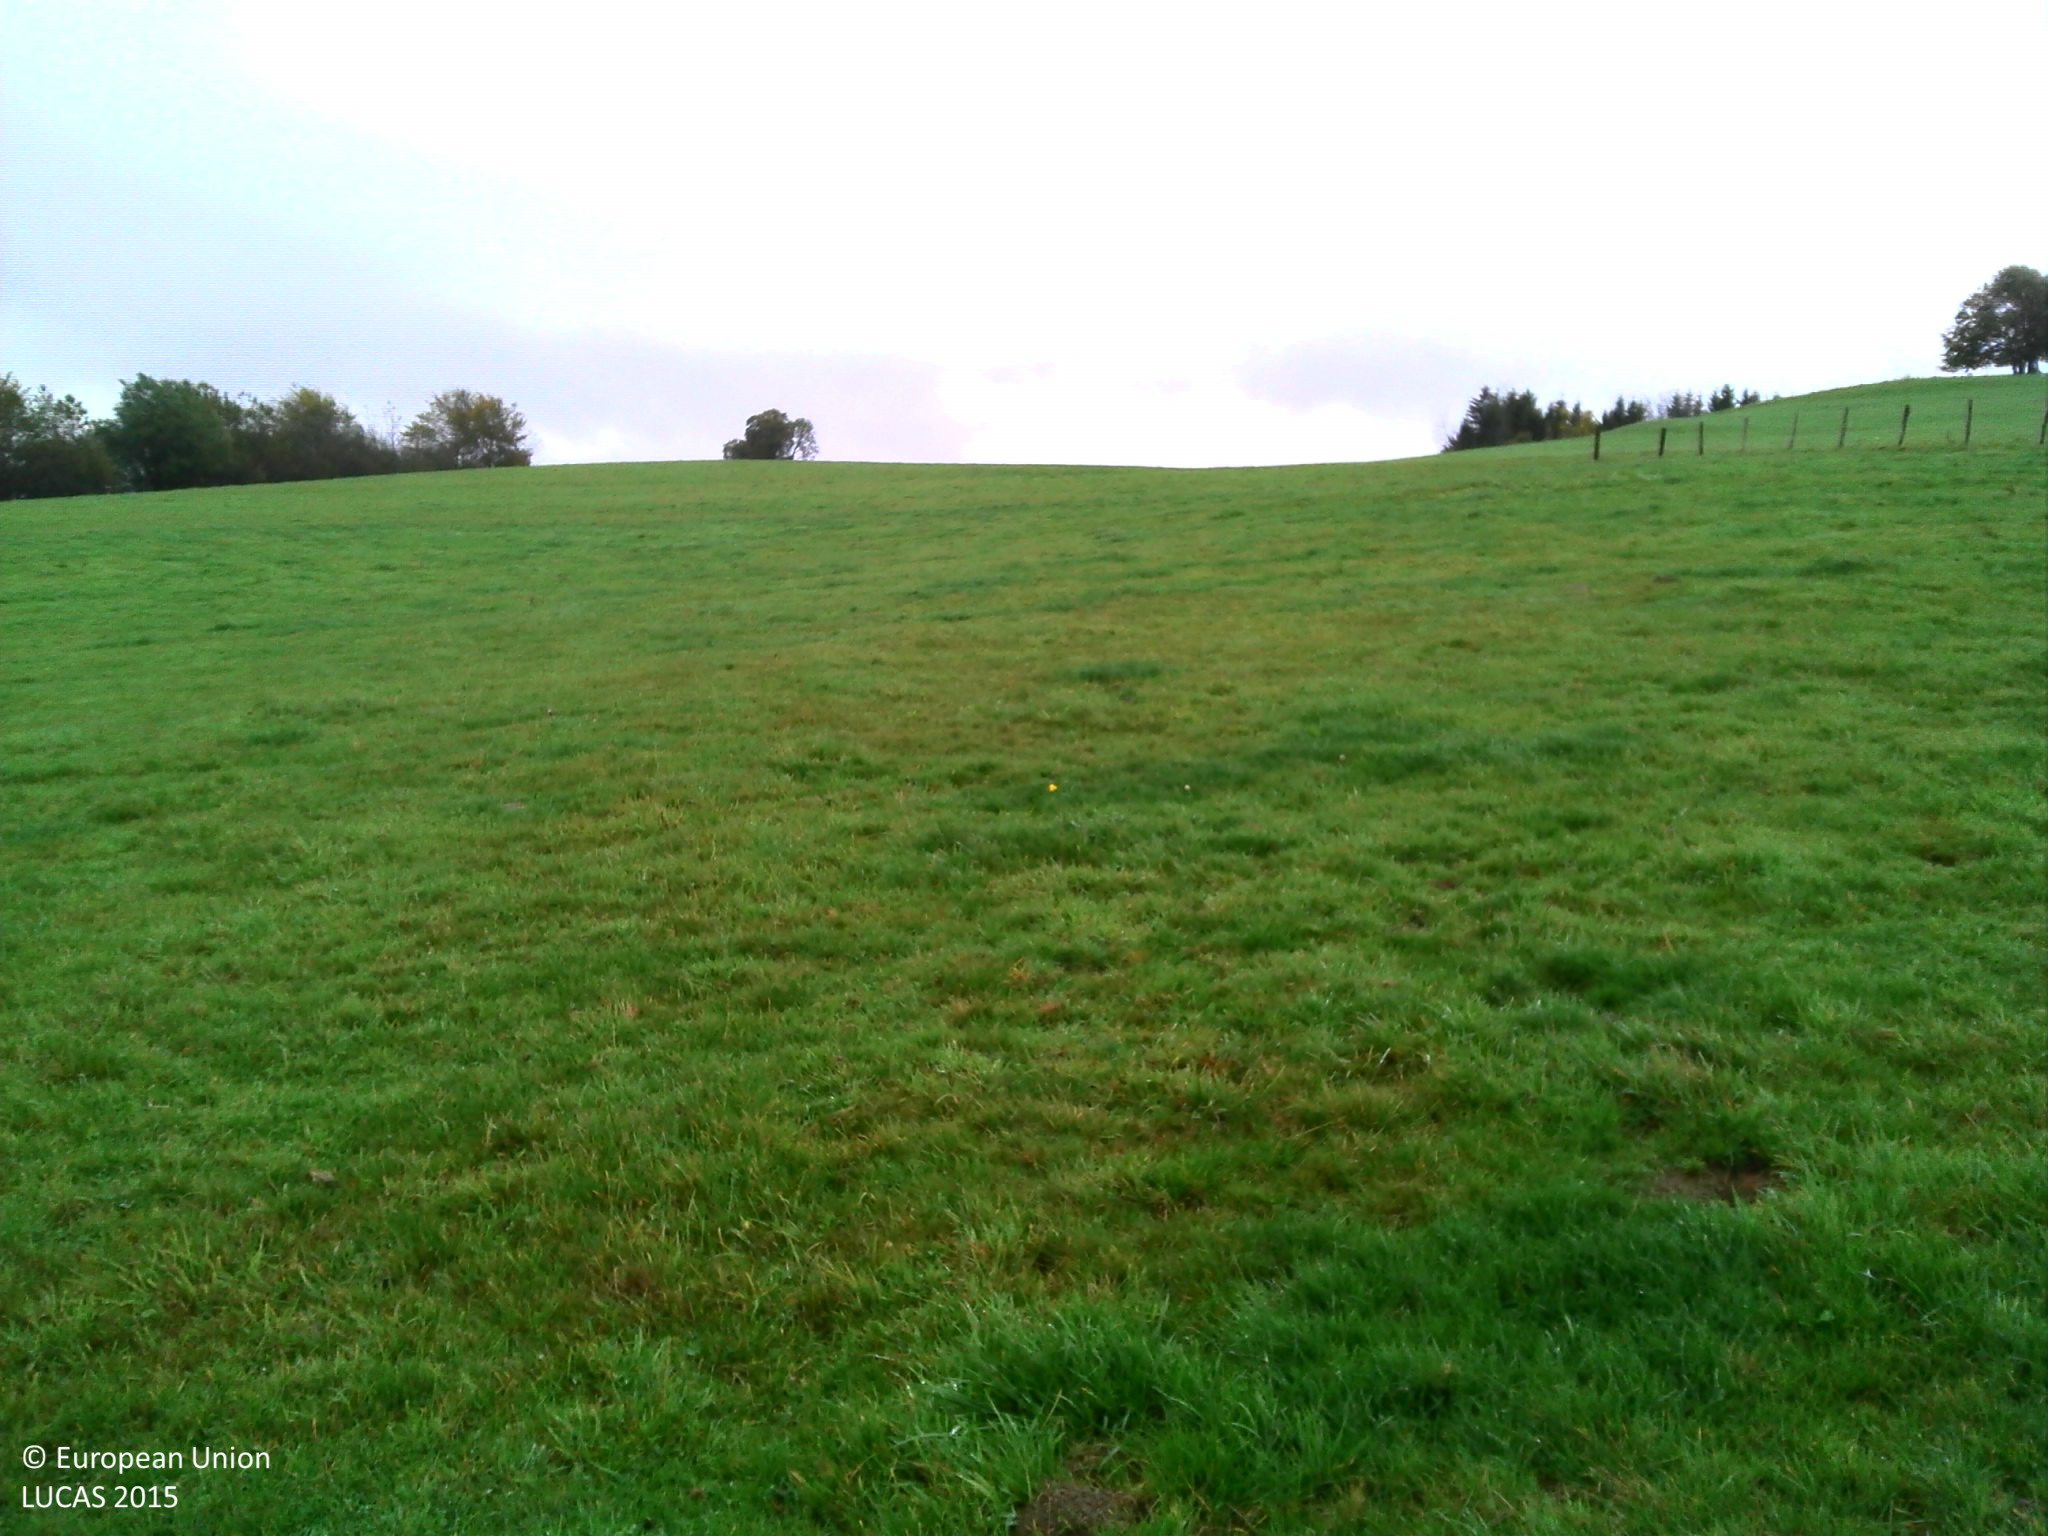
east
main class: Grassland
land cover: Grassland without tree/shrub cover
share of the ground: > 75 %
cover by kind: herbaceous plants 100 %
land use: Agriculture (excluding fallow land and kitchen gardens)
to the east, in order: Grassland without tree/shrub cover; Fences; Grassland without tree/shrub cover; Fences; Grass margins; Paved roads, cycling and walking lanes
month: October
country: FR
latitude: 47.0030
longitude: 6.1487
